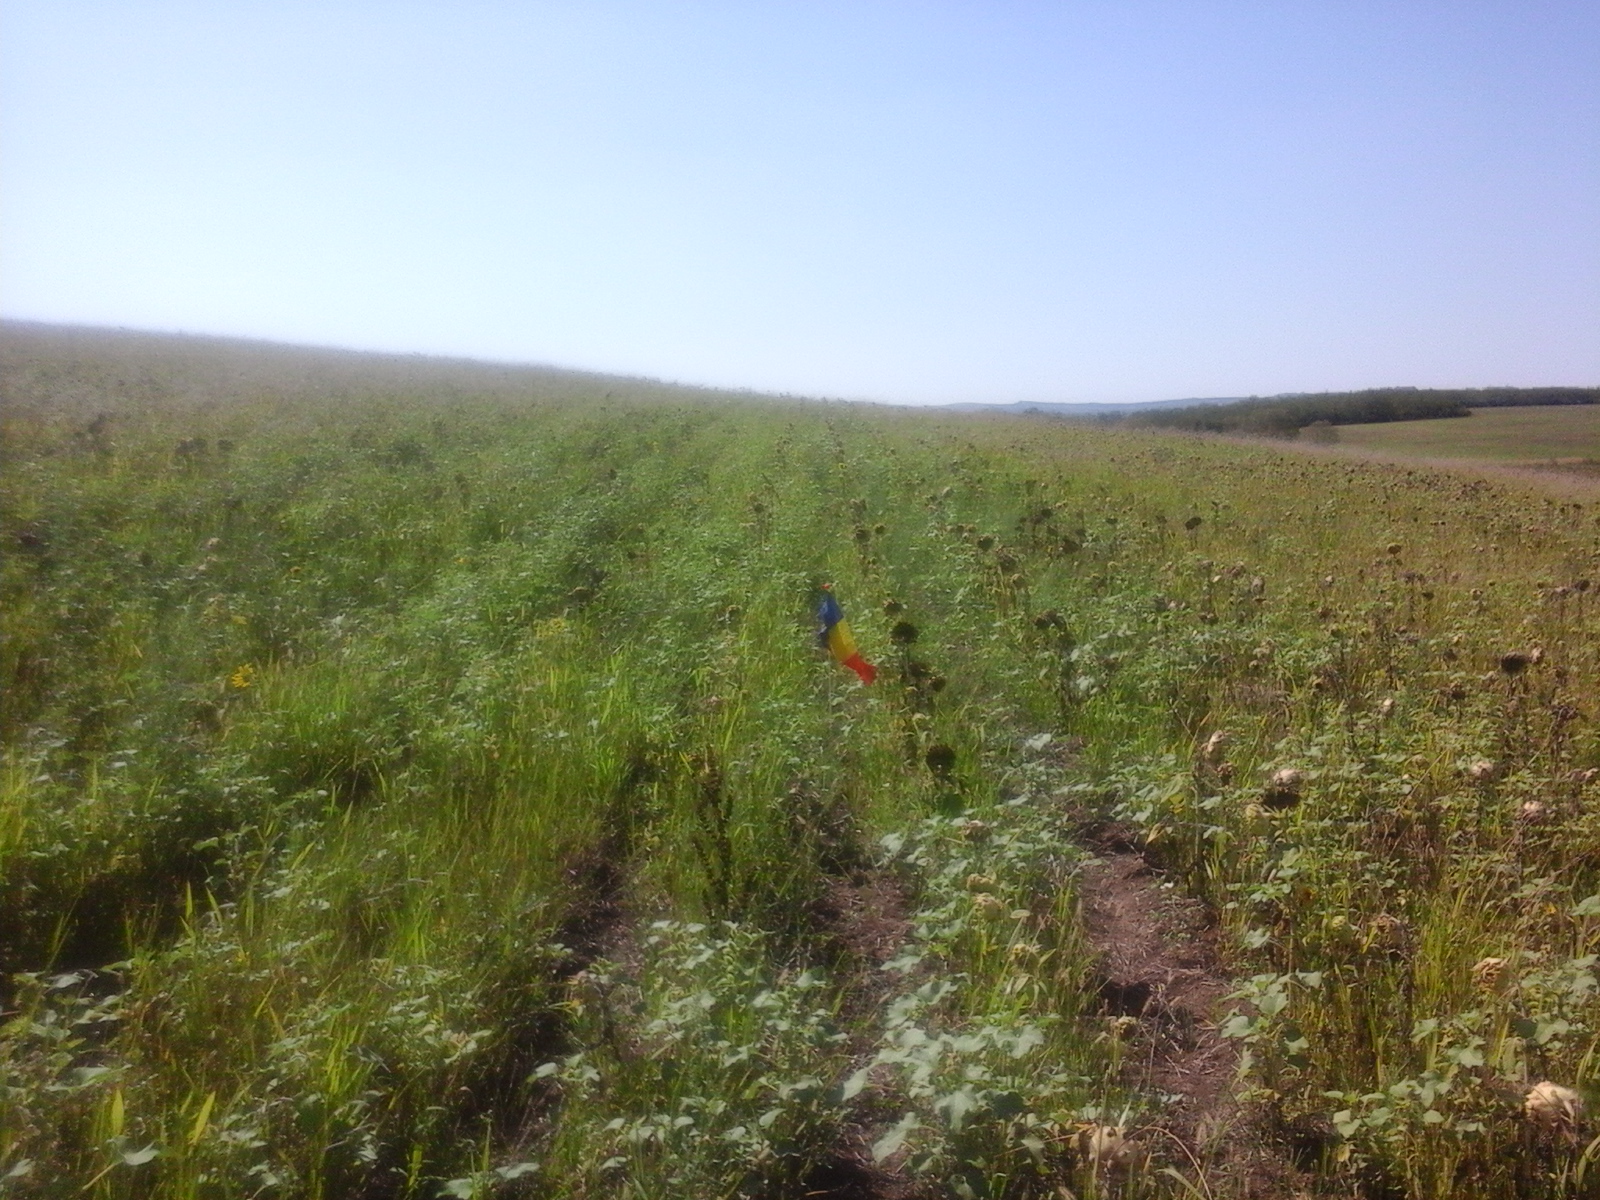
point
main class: Cropland
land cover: Sunflower
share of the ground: 50 - 75 %
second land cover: Spontaneously vegetated surfaces
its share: > 75 %
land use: Agriculture (excluding fallow land and kitchen gardens)
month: August
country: RO
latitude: 45.6315
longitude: 21.7216
